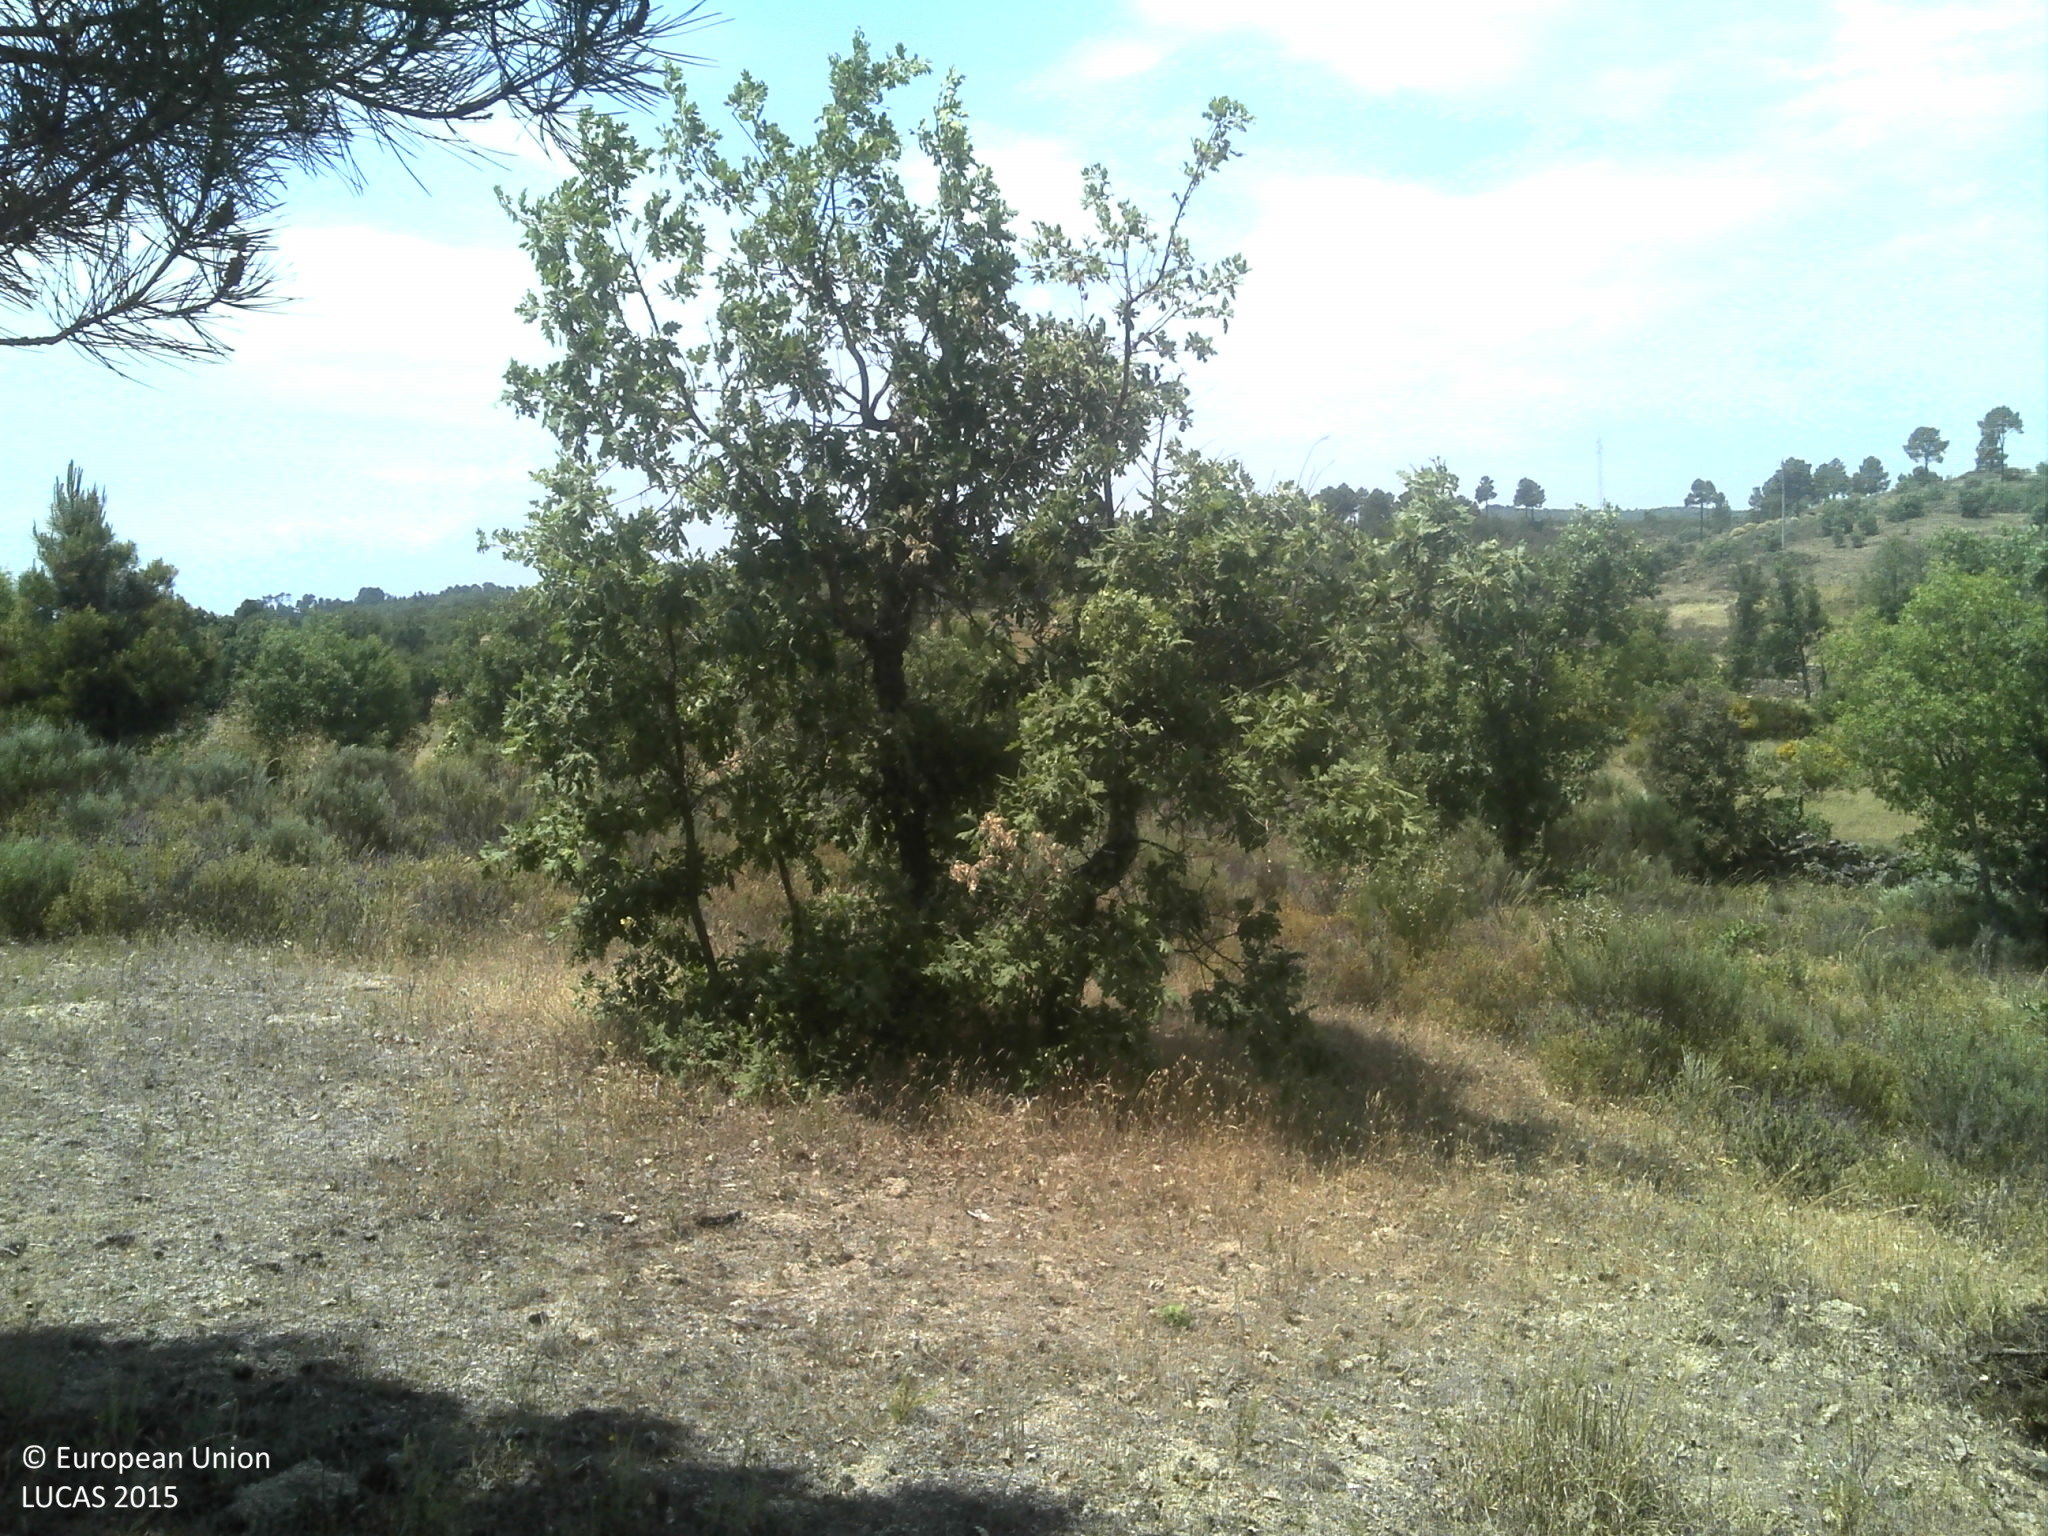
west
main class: Woodland
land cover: Pine dominated coniferous woodland
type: coniferous forest of the mediterranean region
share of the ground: 25 - 50 %
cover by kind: coniferous forest trees 50 %, unconsolidated bare surface 15 %, shrubs 10 %, herbaceous plants 10 %, lichens and mosses 10 %, broadleaved forest trees 5 %
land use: Forestry
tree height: > 5 m
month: June
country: PT
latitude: 40.5164
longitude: -7.0368
